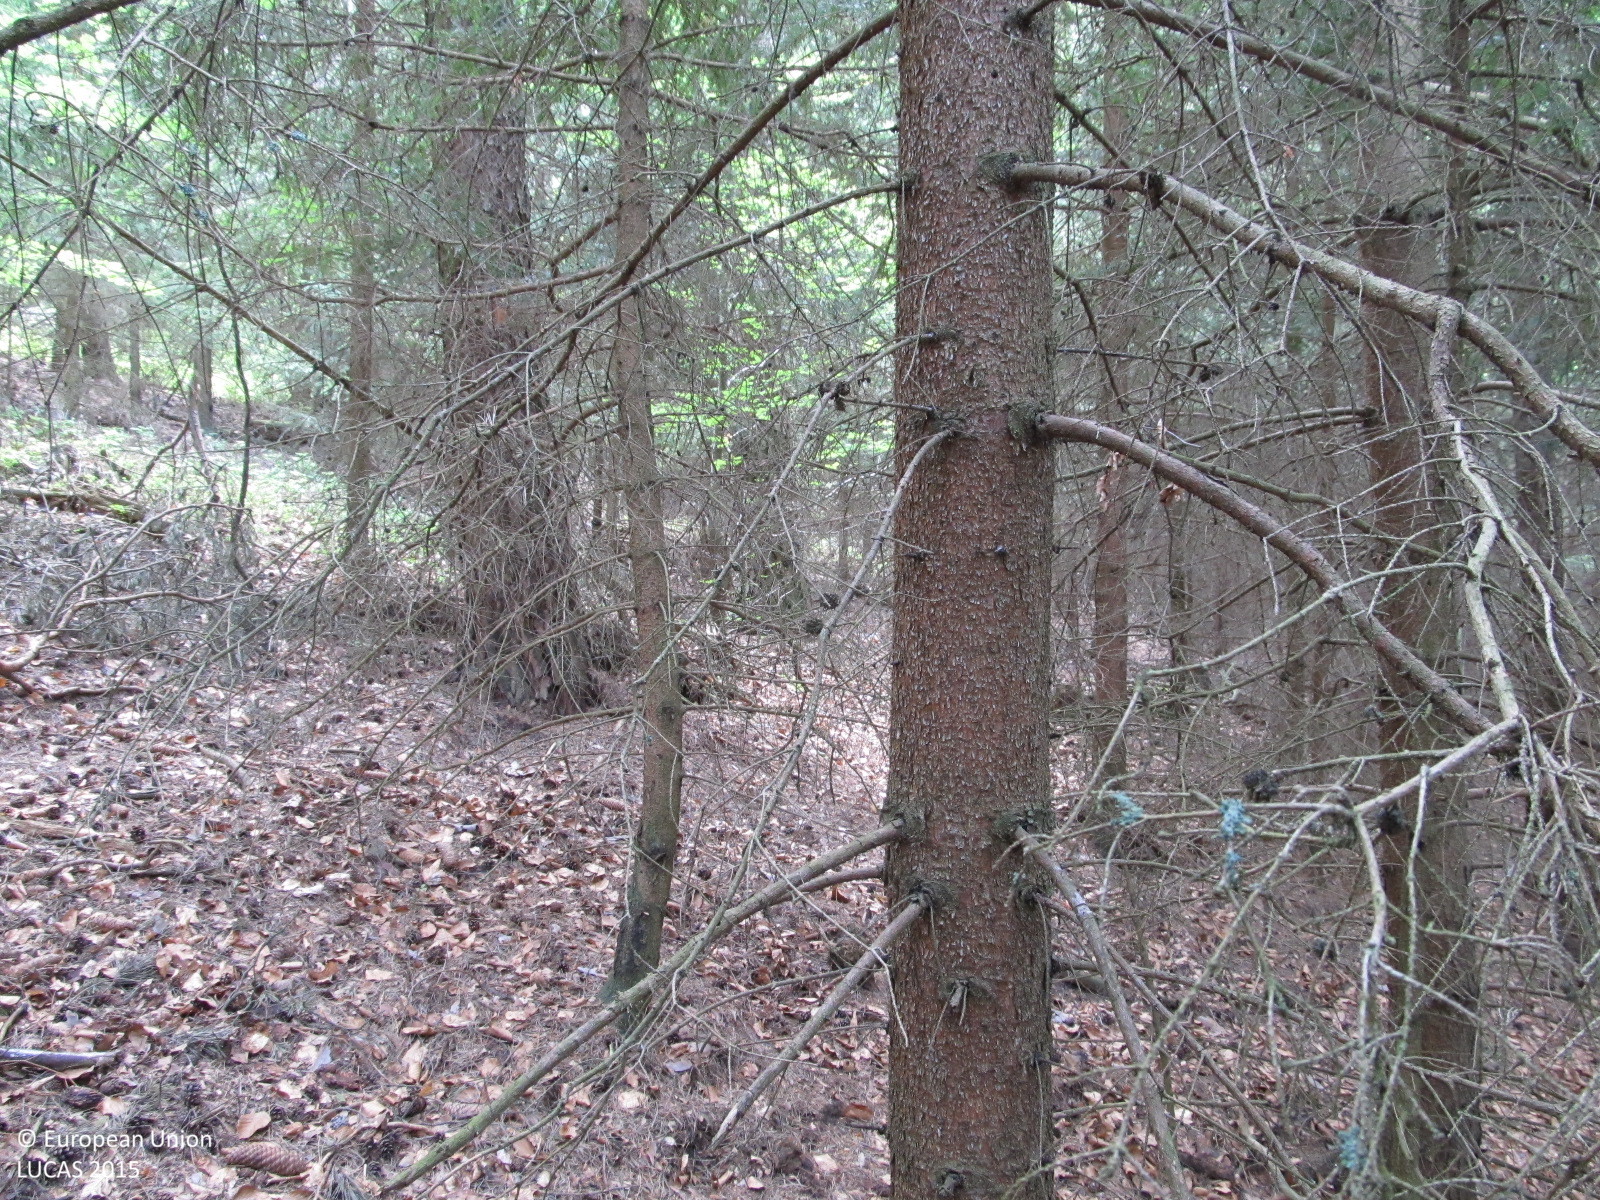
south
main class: Woodland
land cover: Spruce dominated coniferous woodland
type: hemiboreal forest and nemoral coniferous forest and mixed broadleaved-coniferous forest
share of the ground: > 75 %
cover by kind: coniferous forest trees 85 %, unconsolidated bare surface 10 %, broadleaved forest trees 5 %
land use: Forestry
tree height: > 5 m
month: June
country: AT
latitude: 48.4301
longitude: 15.4762
